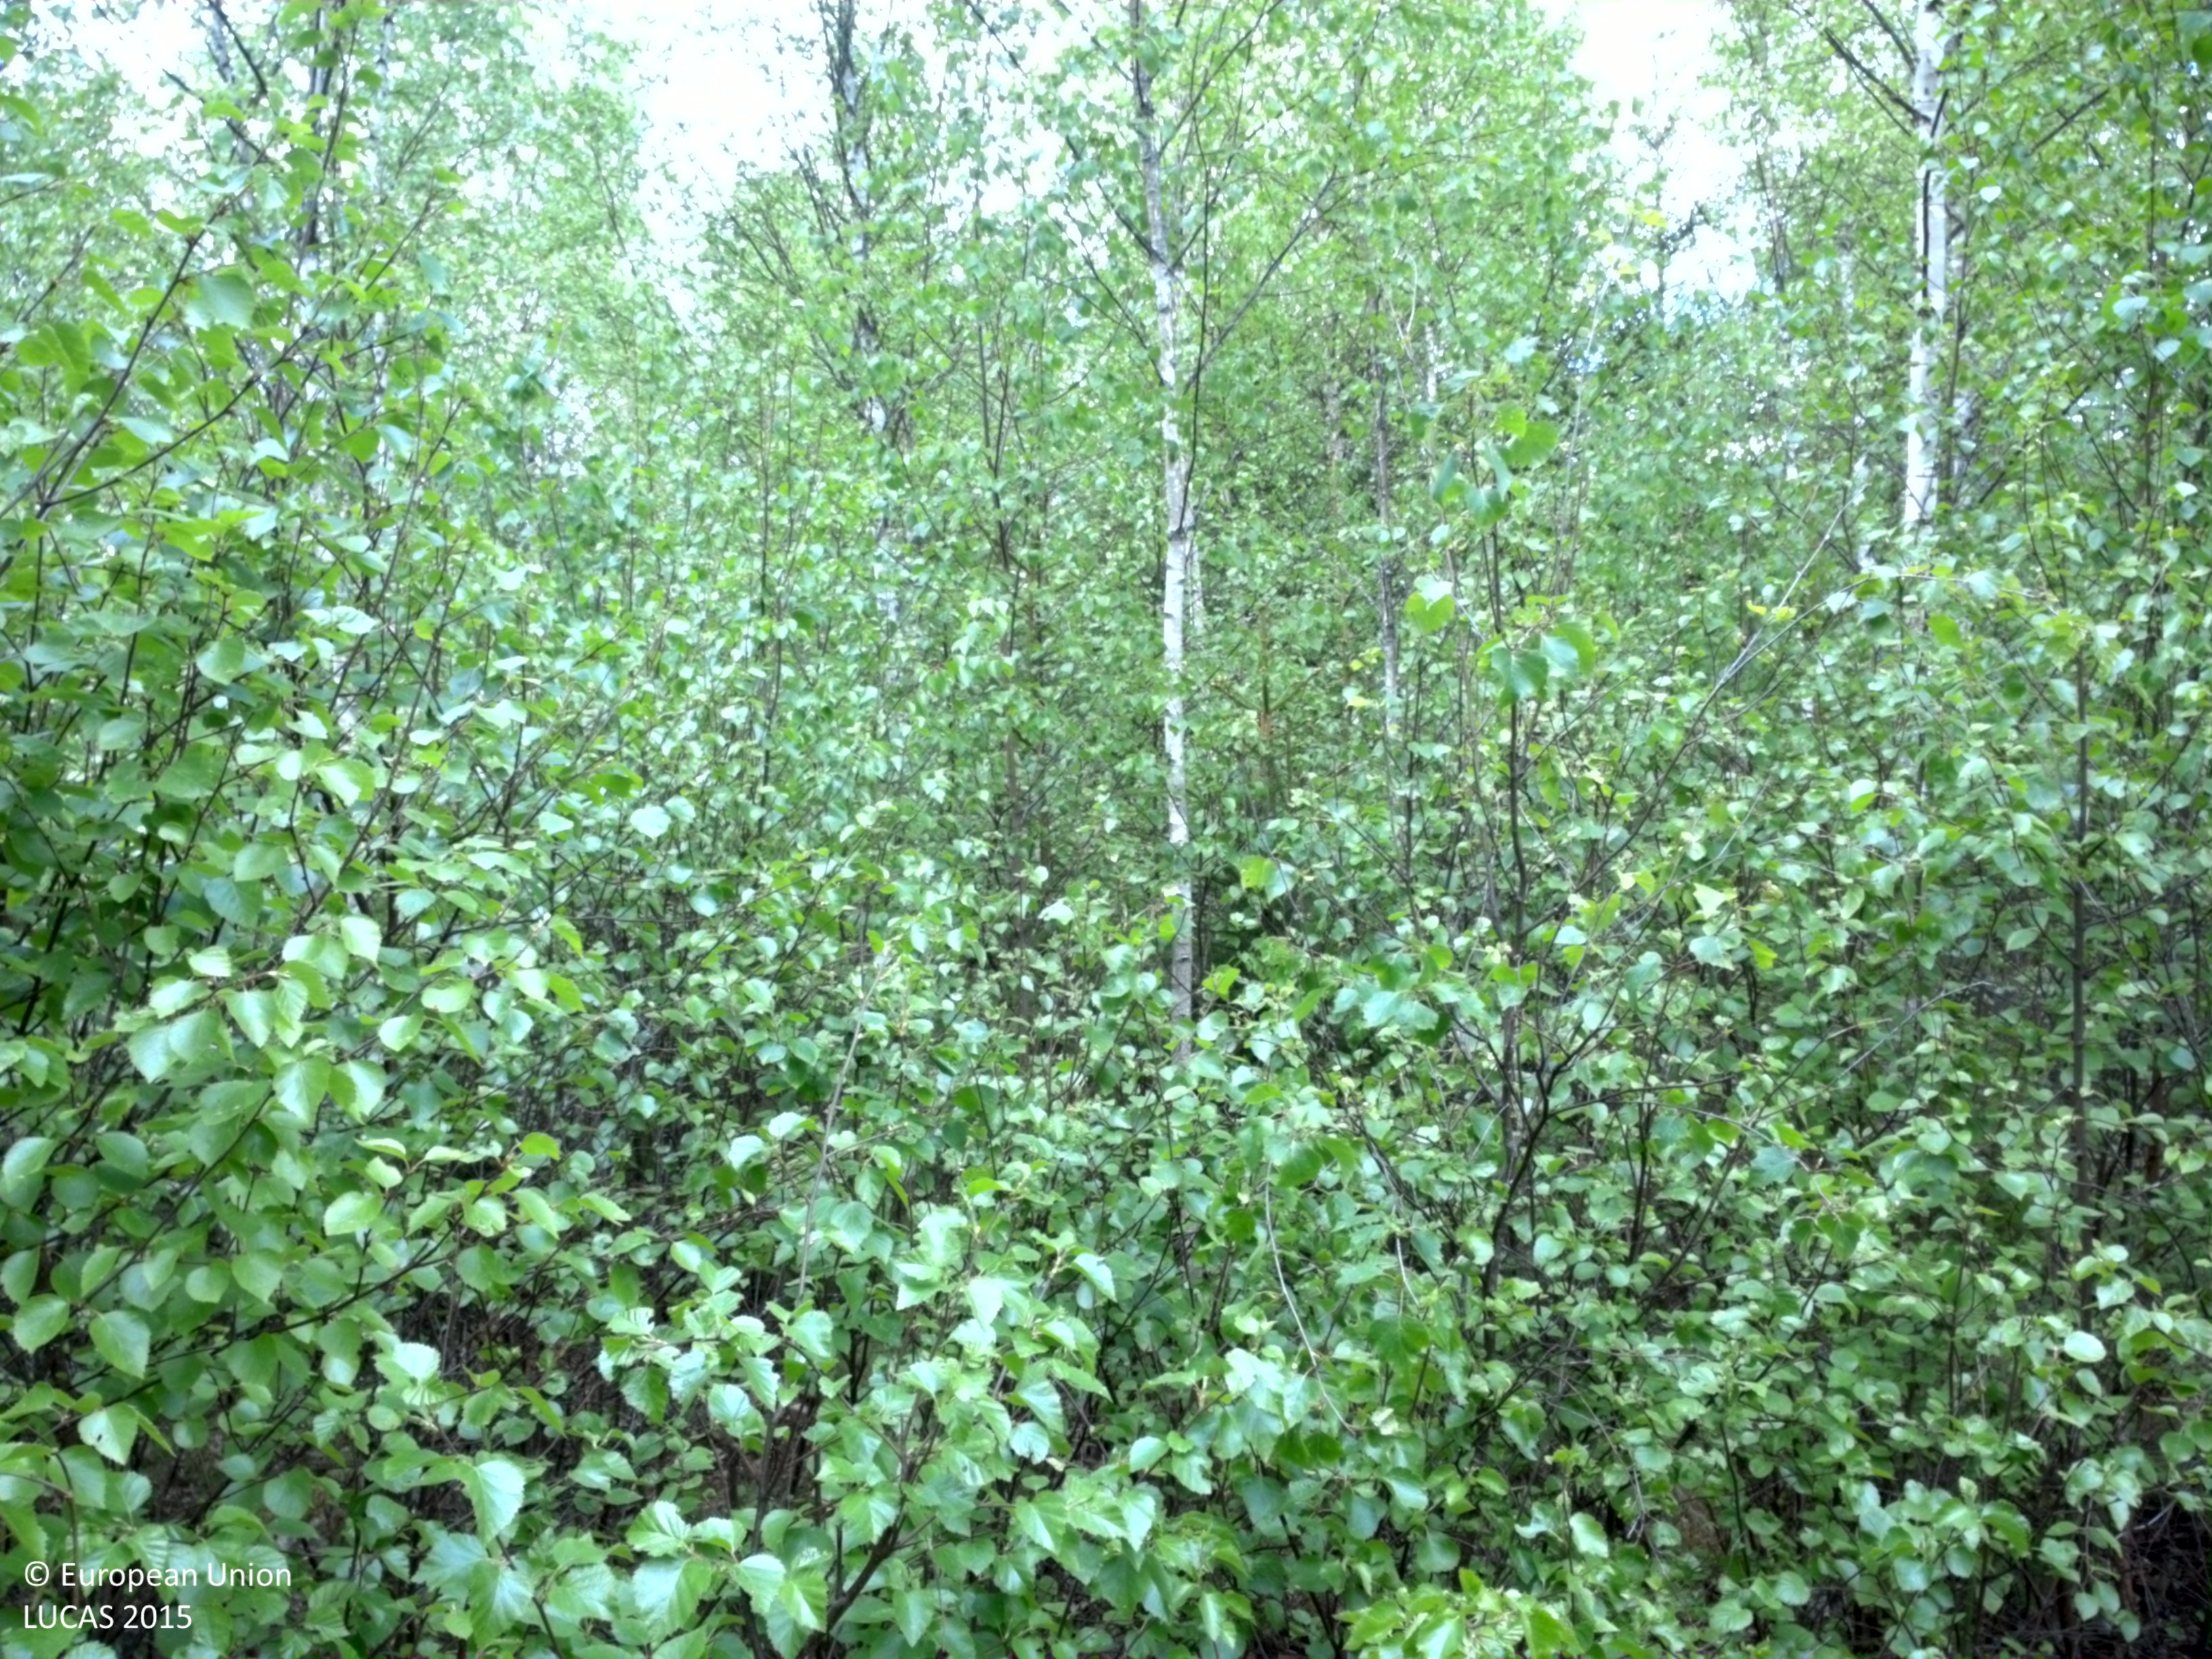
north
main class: Woodland
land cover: Broadleaved woodland
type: boreal forest
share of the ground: 50 - 75 %
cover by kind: broadleaved forest trees 60 %, coniferous forest trees 10 %, shrubs 10 %, herbaceous plants 10 %, lichens and mosses 10 %
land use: Forestry
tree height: > 5 m
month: May
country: SE
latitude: 57.2760
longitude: 15.9525
